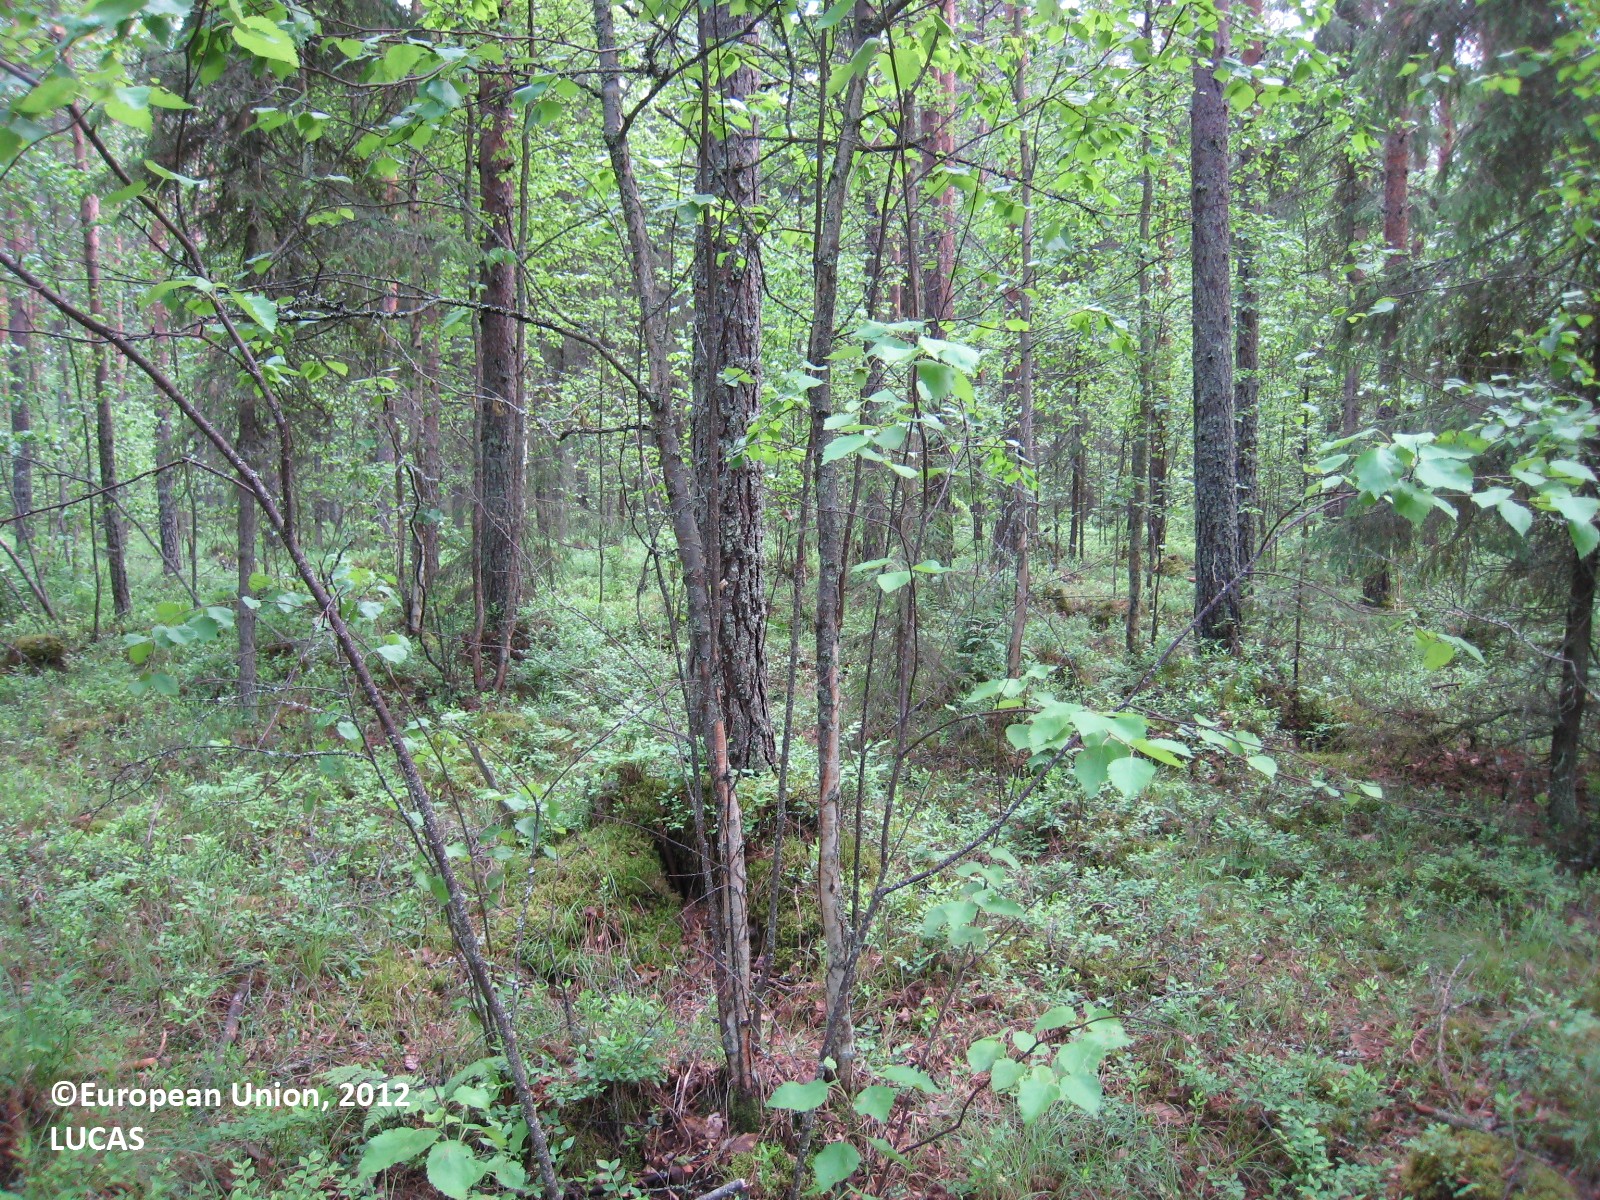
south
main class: Woodland
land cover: Pine dominated mixed woodland
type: boreal forest
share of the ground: 50 - 75 %
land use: Forestry
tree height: > 5 m
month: June
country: FI
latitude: 62.4895
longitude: 25.9782
